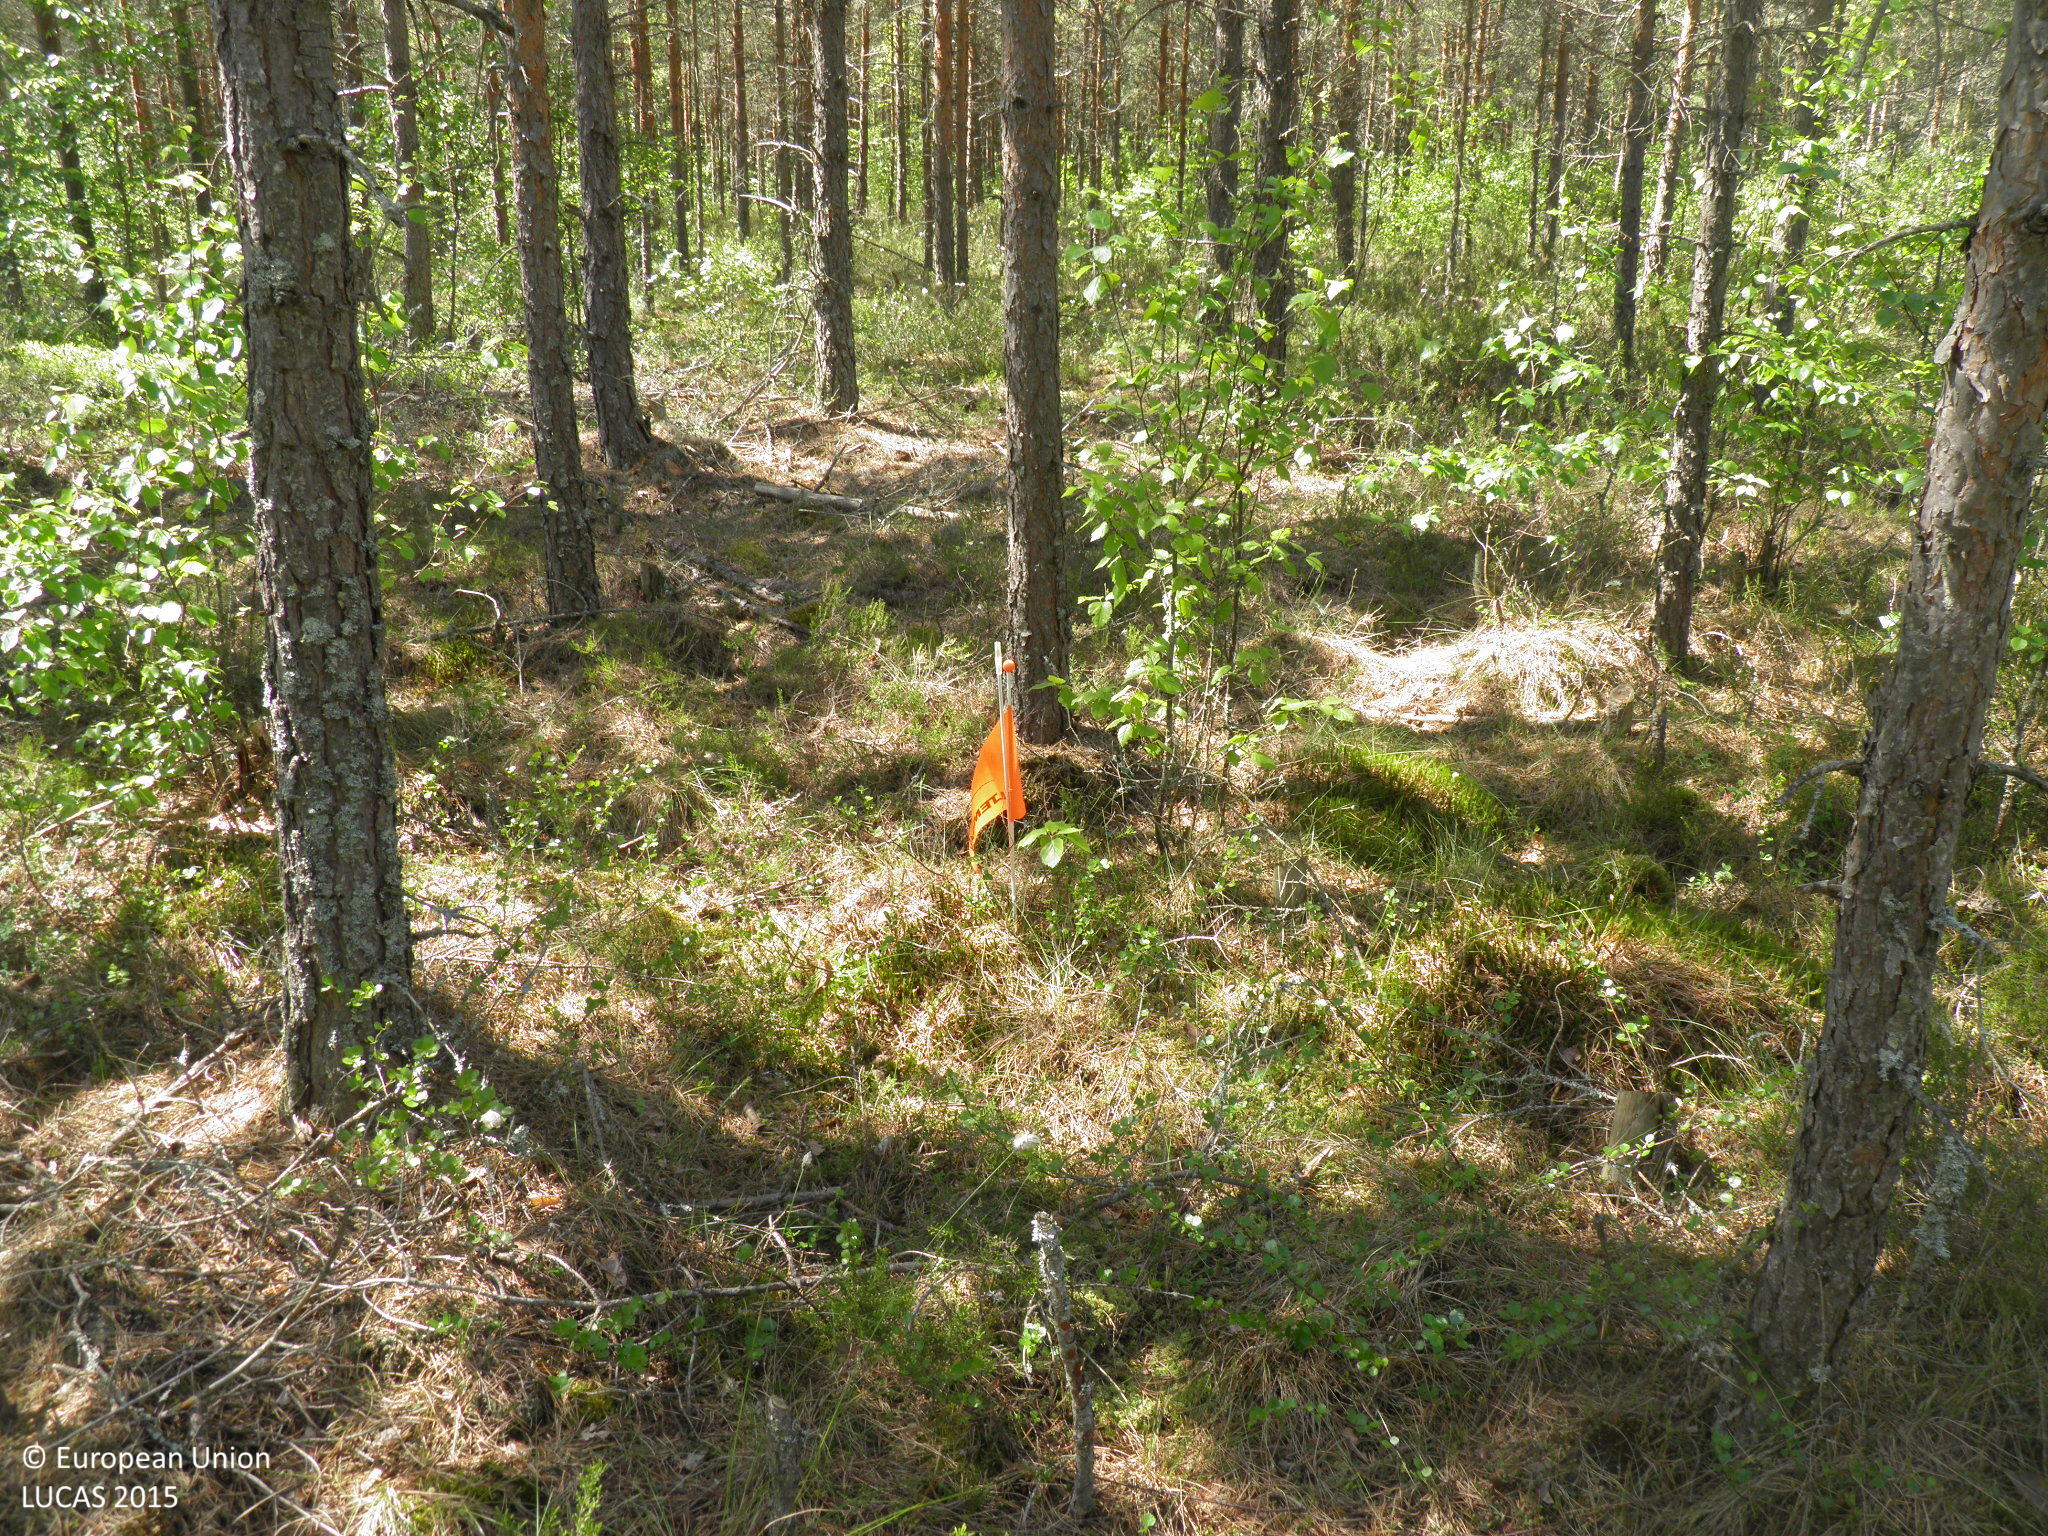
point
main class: Woodland
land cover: Pine dominated coniferous woodland
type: boreal forest
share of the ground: > 75 %
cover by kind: coniferous forest trees 80 %, broadleaved forest trees 5 %, shrubs 5 %, herbaceous plants 5 %, lichens and mosses 5 %
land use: Forestry
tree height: < 5 m
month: June
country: FI
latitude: 60.3875
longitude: 22.7198
